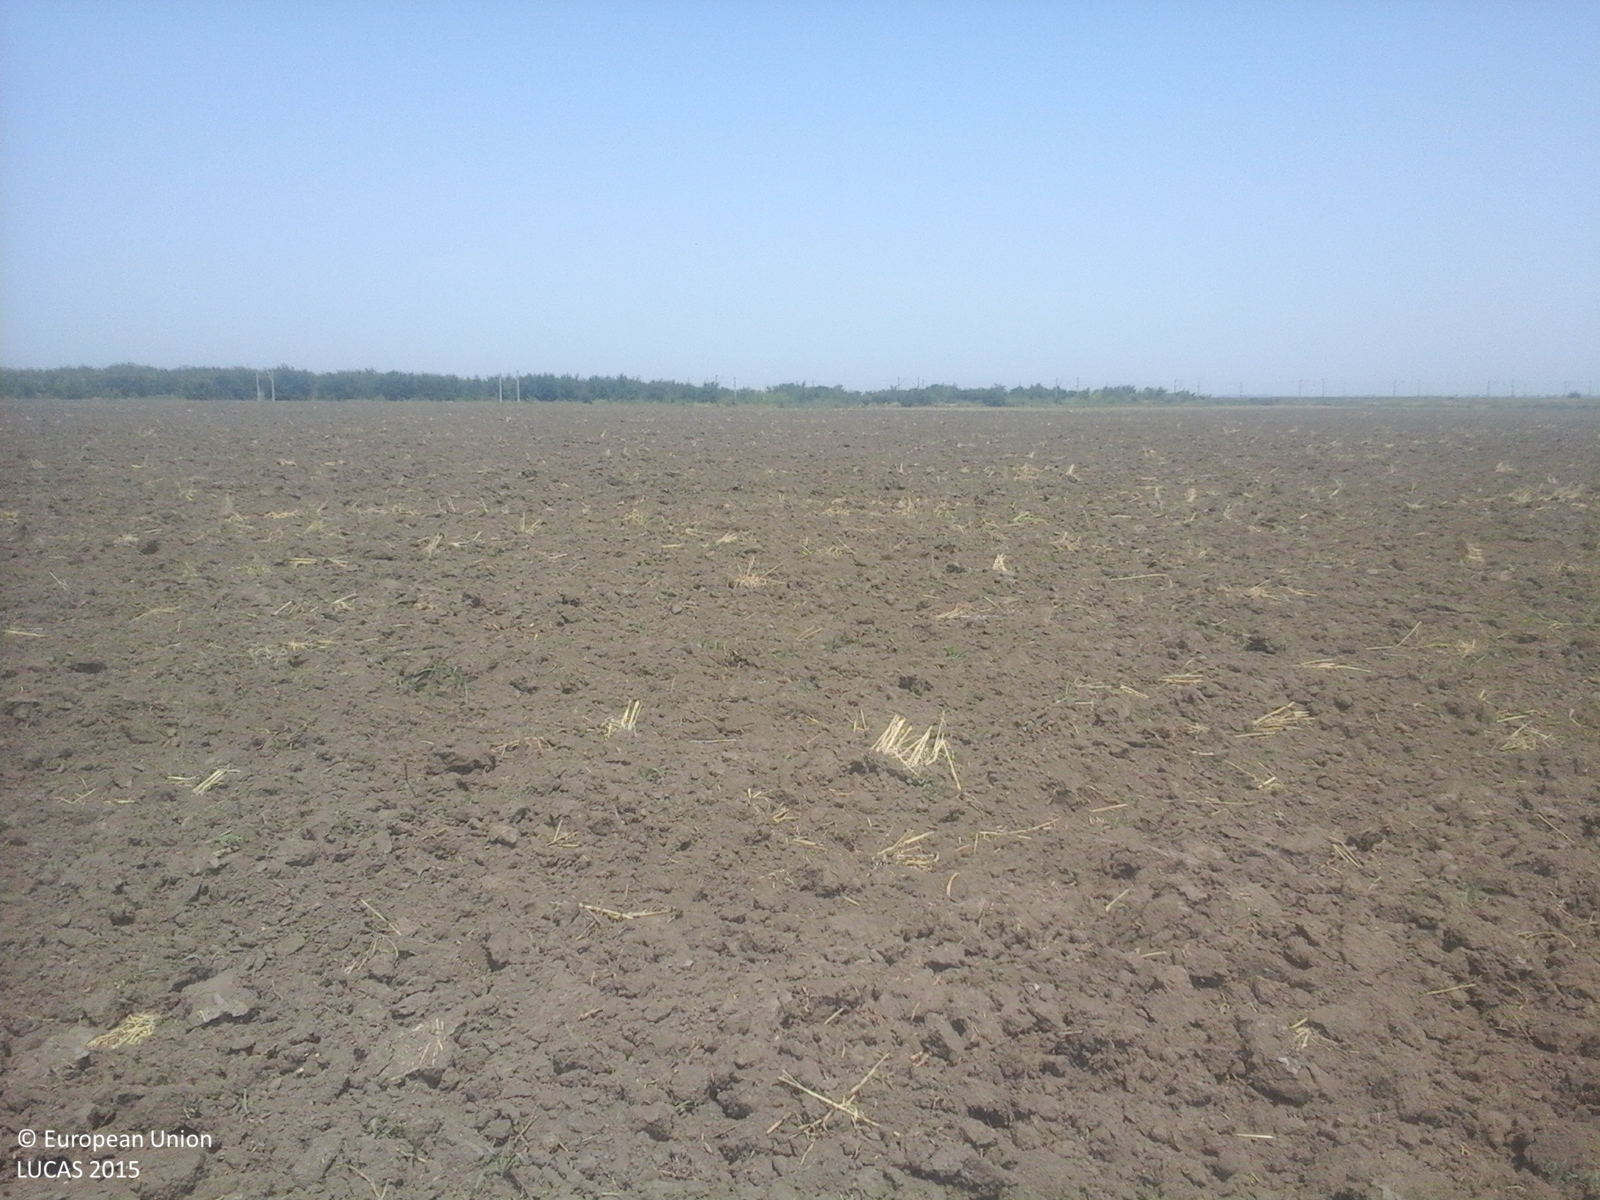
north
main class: Cropland
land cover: Common wheat
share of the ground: < 10 %
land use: Agriculture (excluding fallow land and kitchen gardens)
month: August
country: RO
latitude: 45.1767
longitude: 27.6779
